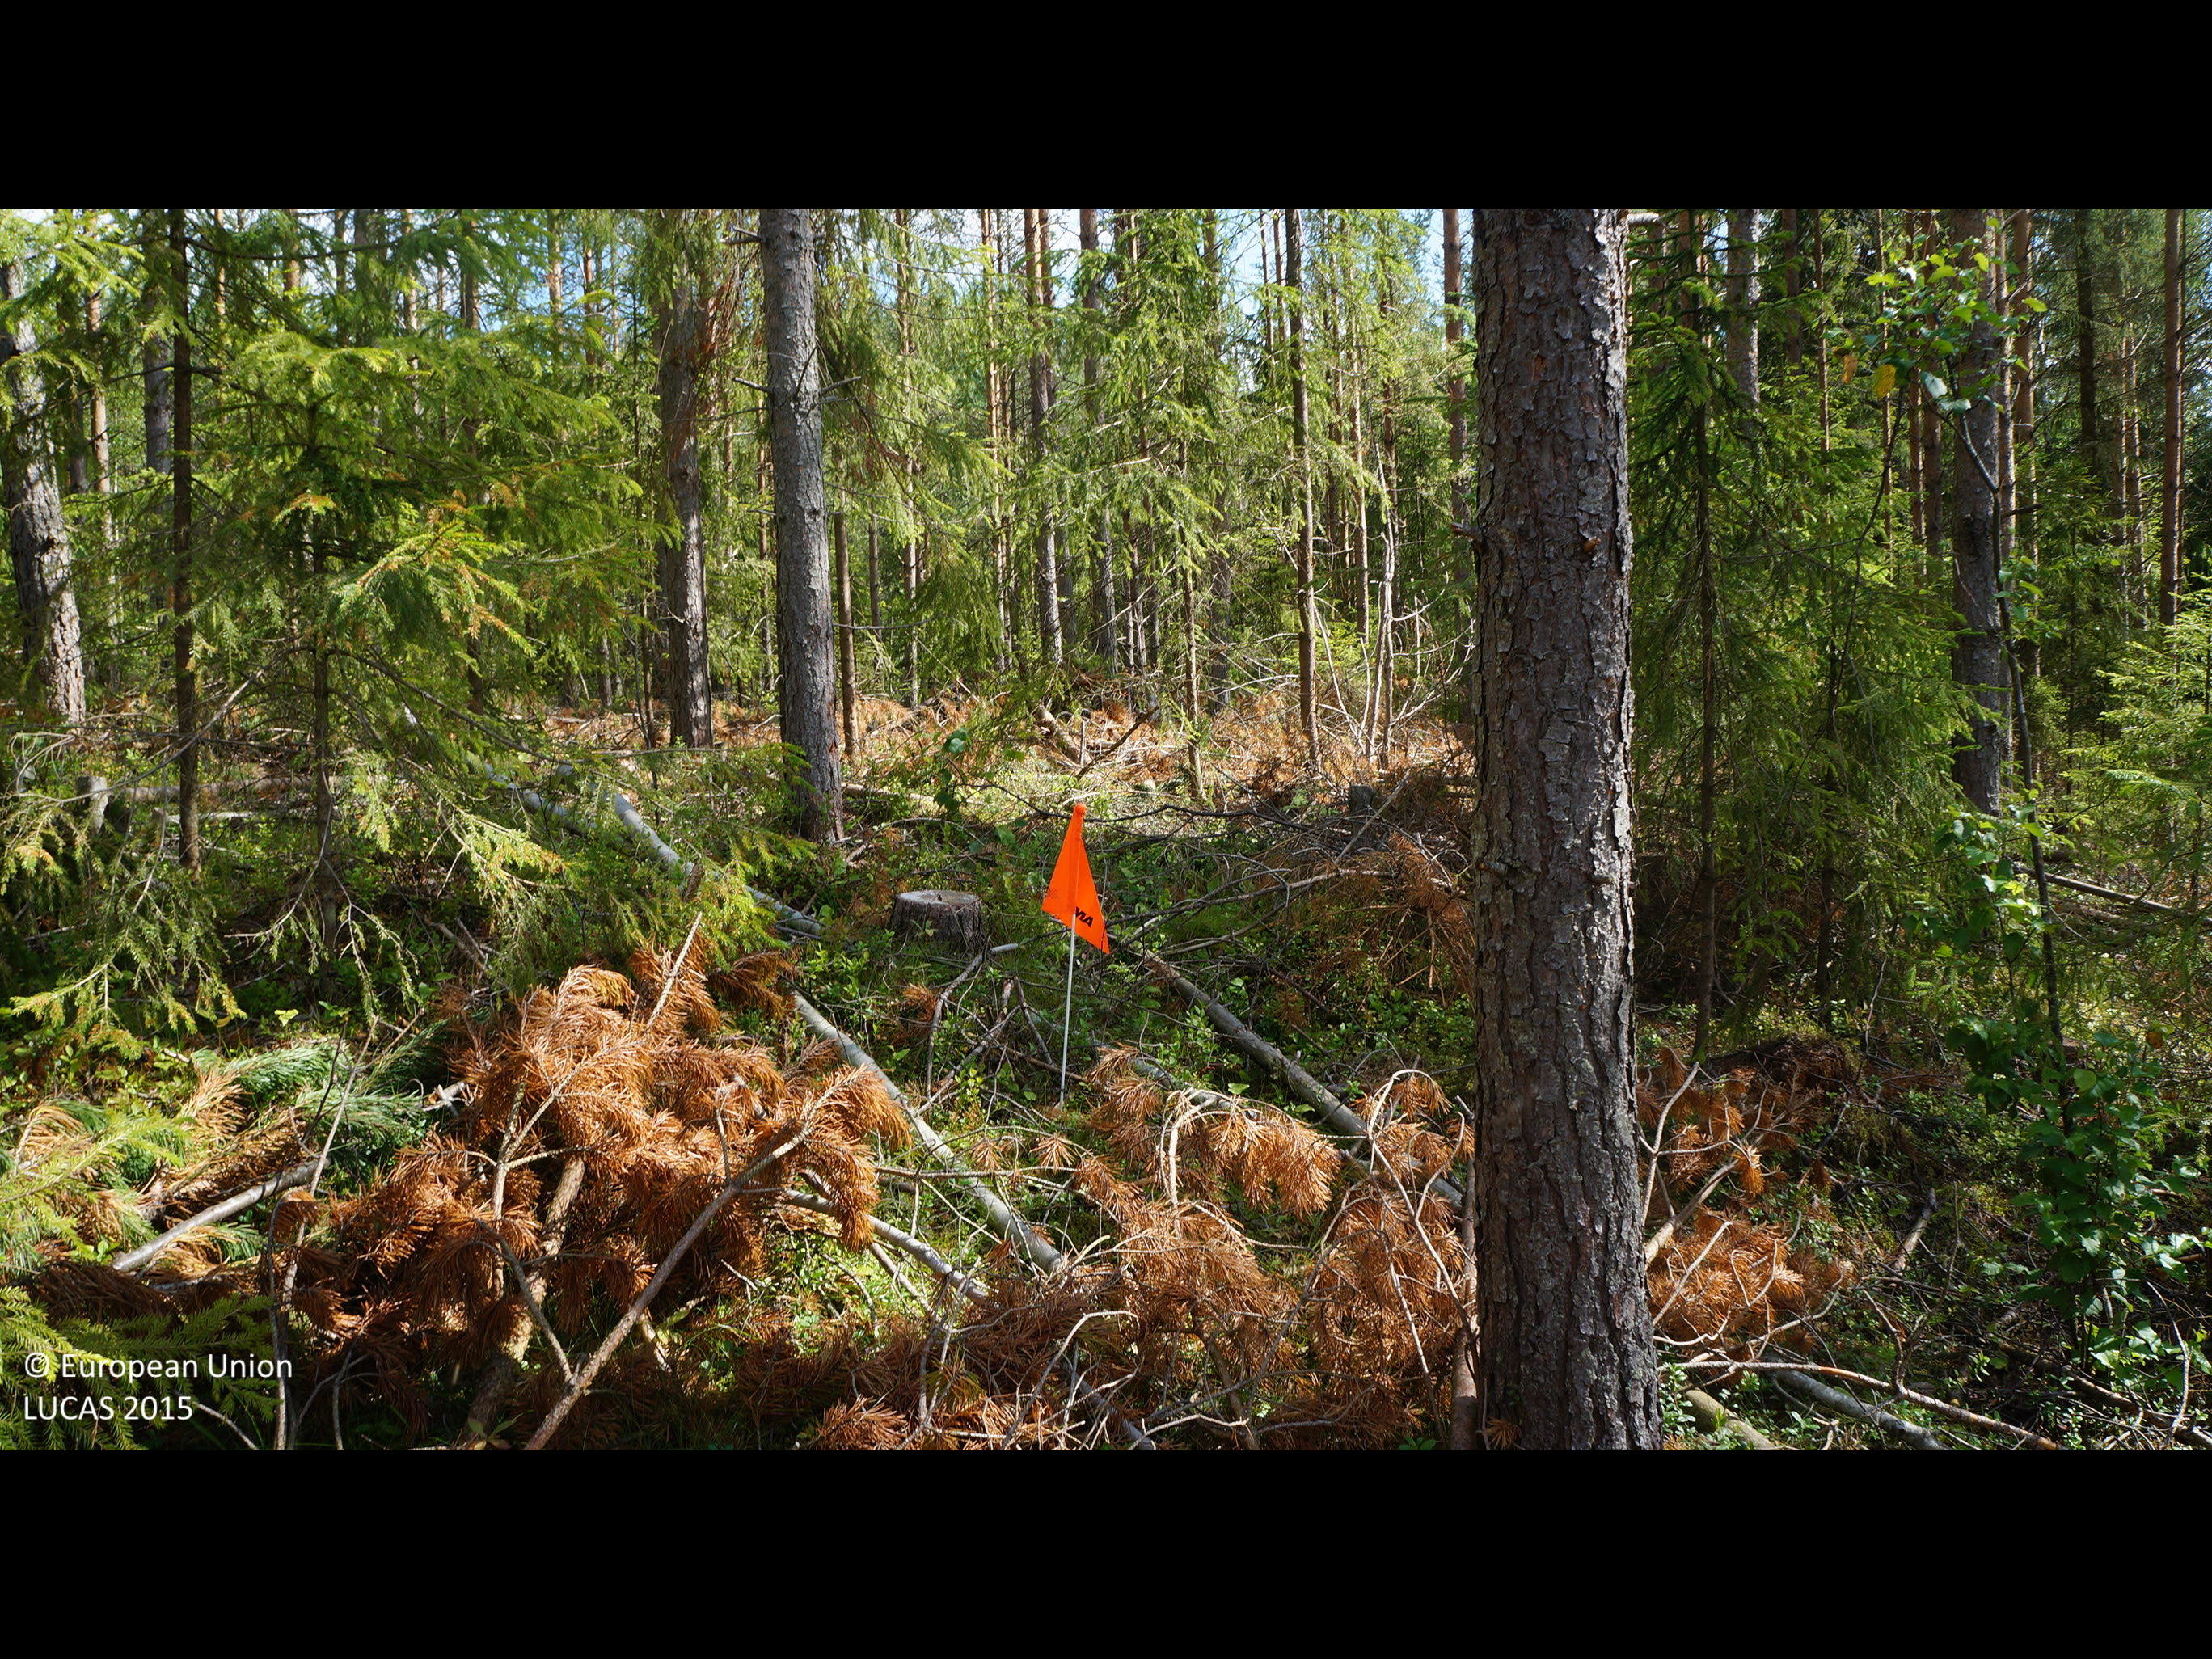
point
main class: Woodland
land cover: Other coniferous woodland
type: boreal forest
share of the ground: 50 - 75 %
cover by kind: coniferous forest trees 55 %, shrubs 30 %, lichens and mosses 10 %
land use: Forestry
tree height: > 5 m
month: July
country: FI
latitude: 63.9241
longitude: 24.3667
